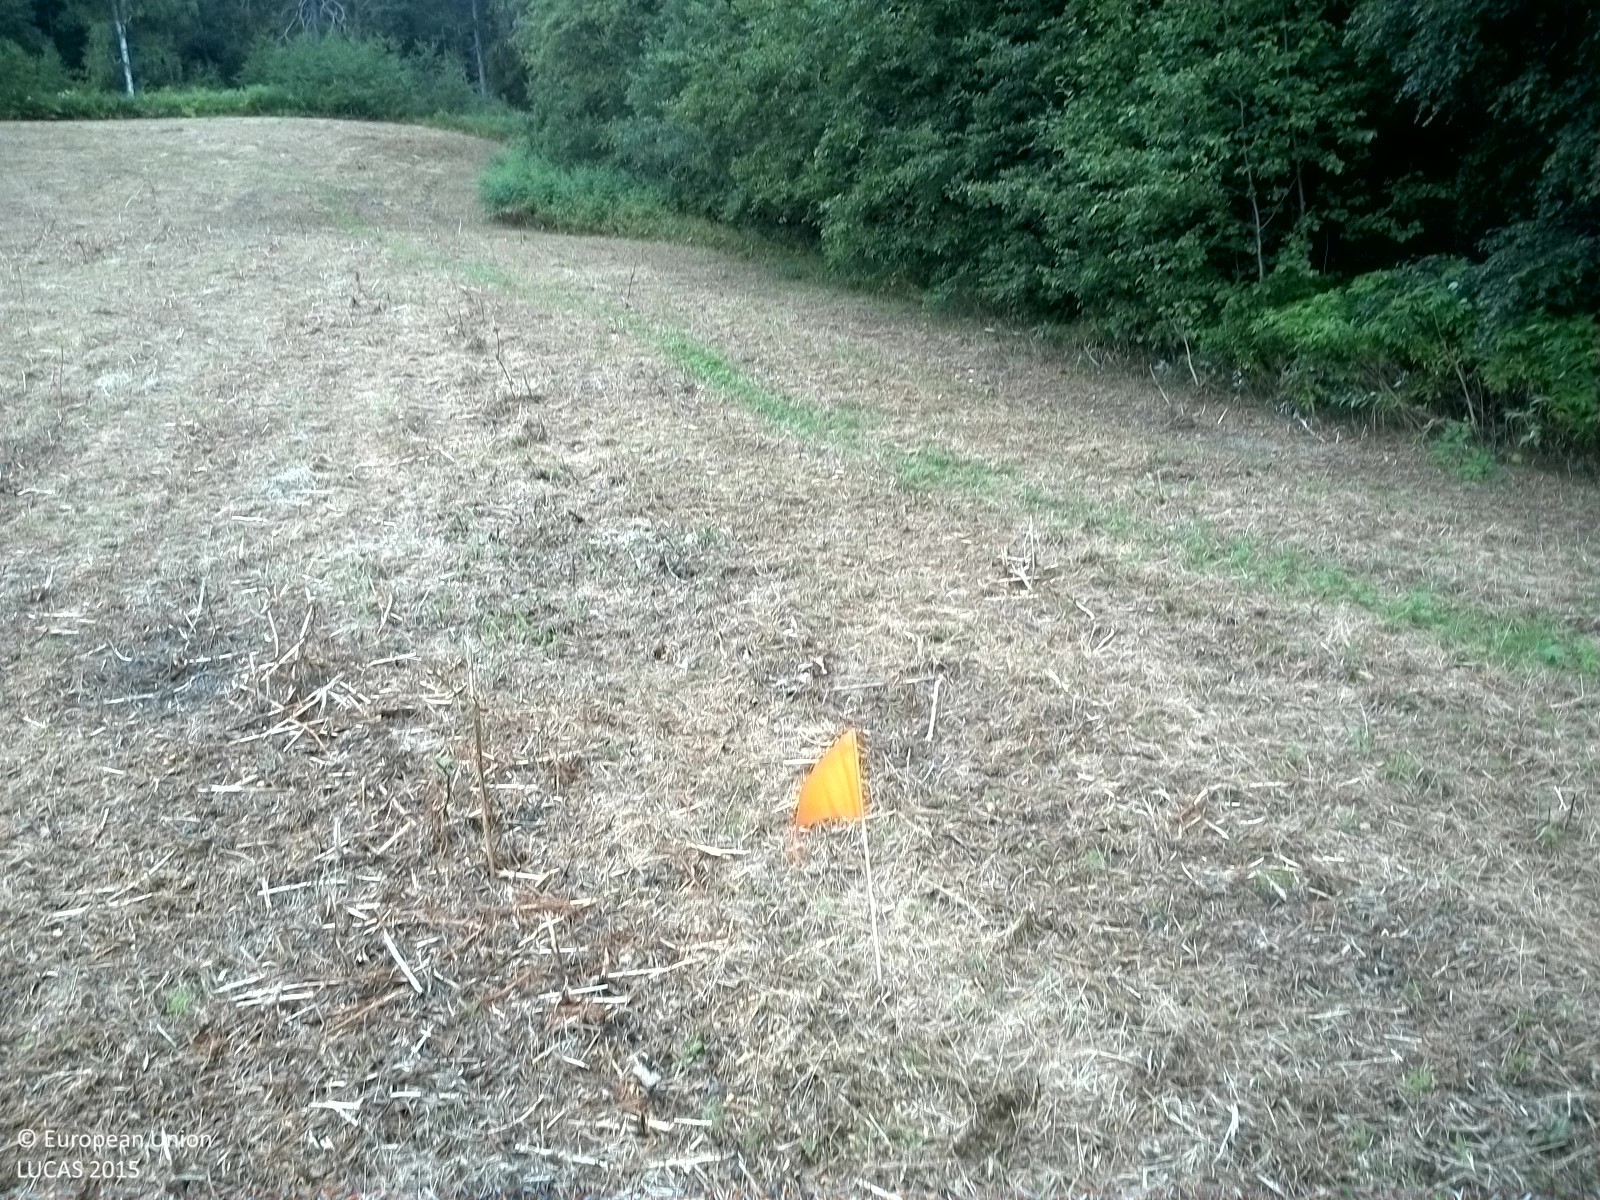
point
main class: Grassland
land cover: Spontaneously vegetated surfaces
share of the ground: < 10 %
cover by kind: herbaceous plants 10 %, unconsolidated bare surface 10 %
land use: Agriculture (excluding fallow land and kitchen gardens)
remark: Harvested field
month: August
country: SE
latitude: 62.5527
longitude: 17.1163
